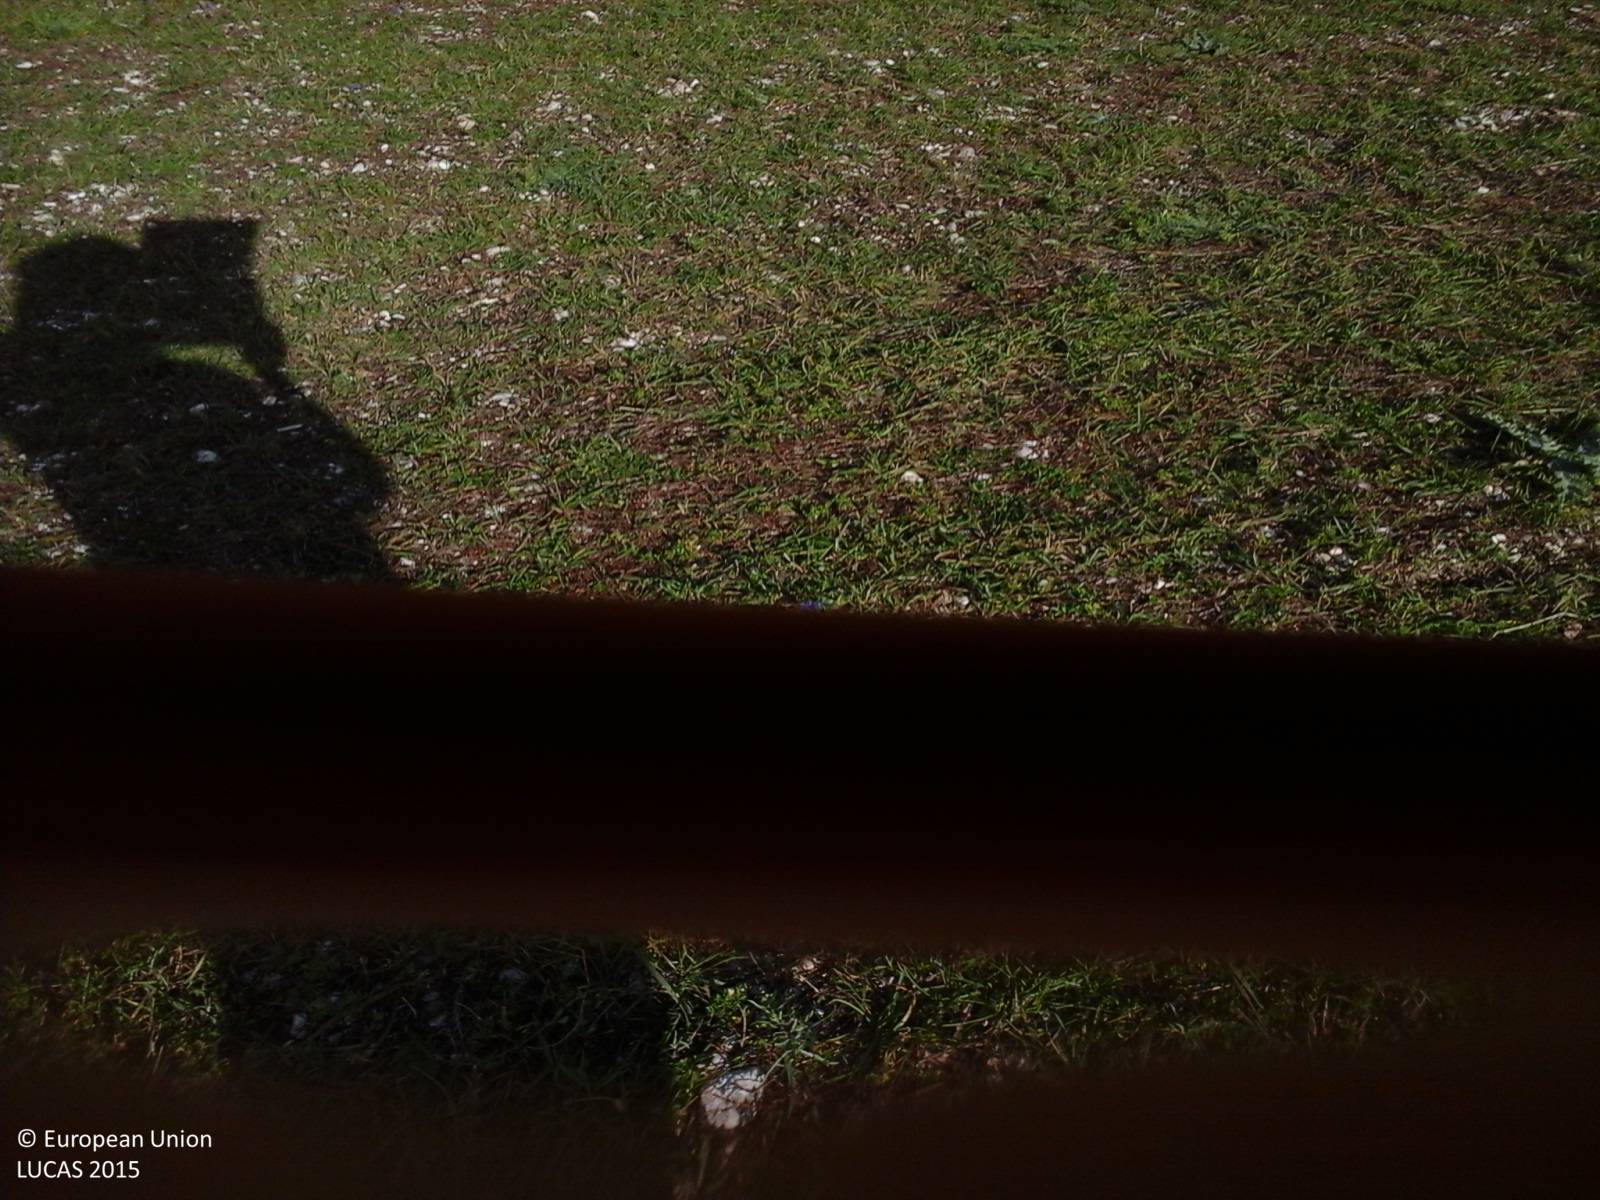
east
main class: Grassland
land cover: Grassland without tree/shrub cover
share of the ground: > 75 %
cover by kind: herbaceous plants 100 %
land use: Agriculture (excluding fallow land and kitchen gardens)
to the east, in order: Grassland without tree/shrub cover
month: October
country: IT
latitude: 42.8201
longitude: 13.2074
